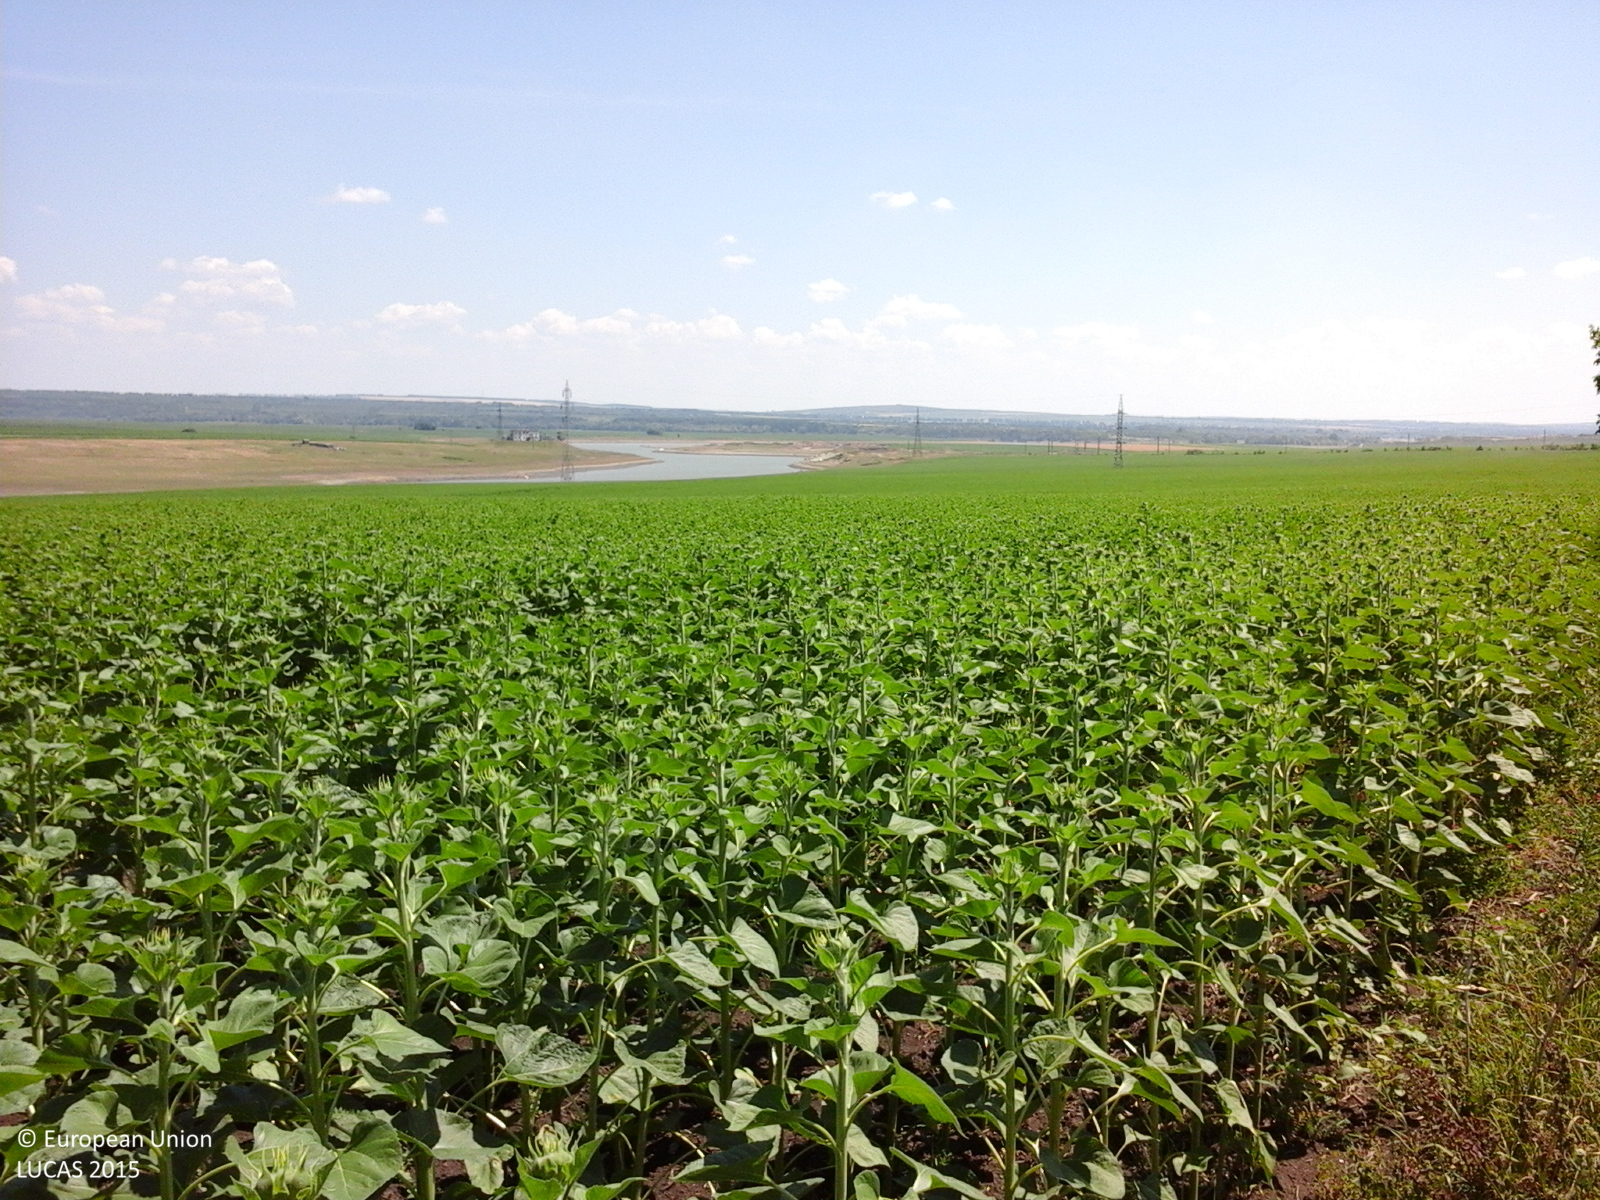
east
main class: Cropland
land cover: Sunflower
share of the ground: > 75 %
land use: Agriculture (excluding fallow land and kitchen gardens)
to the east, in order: Sunflower
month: June
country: RO
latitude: 47.9761
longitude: 27.1096
